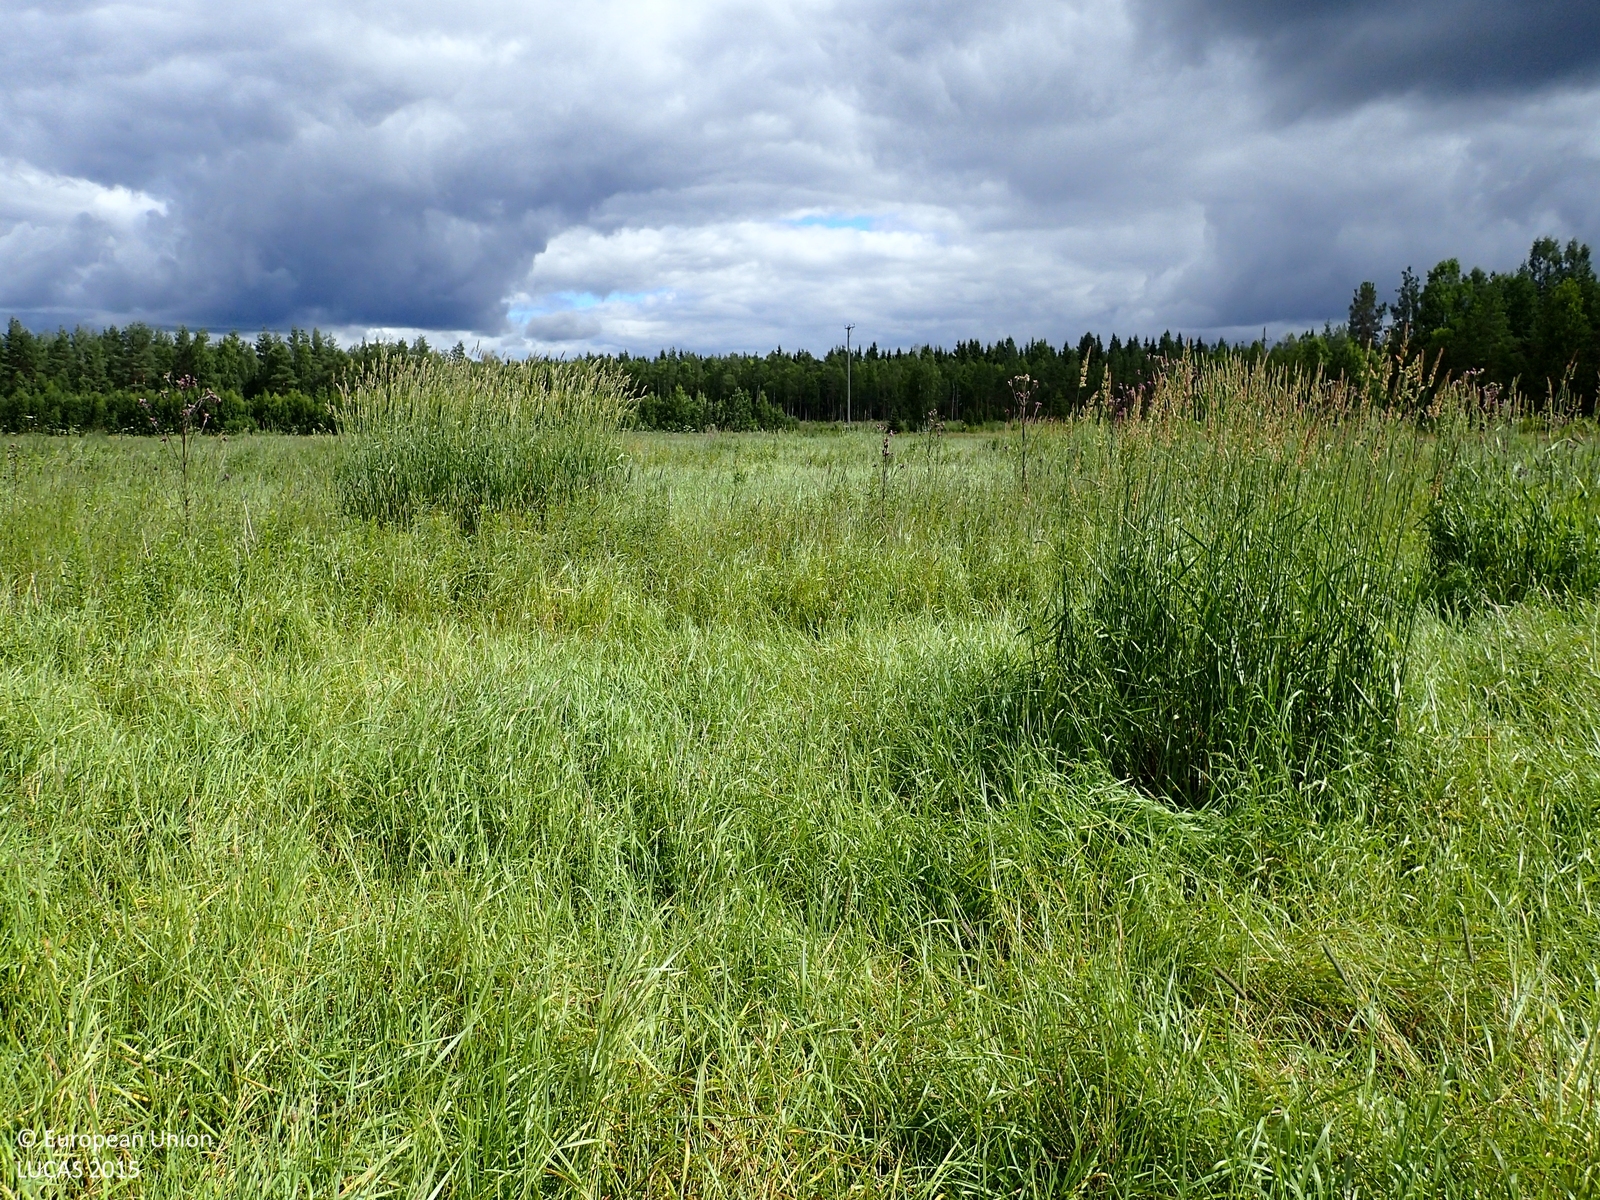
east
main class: Grassland
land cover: Spontaneously vegetated surfaces
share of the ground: > 75 %
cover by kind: herbaceous plants 100 %
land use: Fallow land
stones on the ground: < 10 %
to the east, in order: Spontaneously vegetated surfaces; Electric lines; Shruby margins; Ditches and canals; Shruby margins; Tracks; Shruby margins; Ditches and canals; Temporary grasslands; Ditches and canals; Temporary grasslands; Ditches and canals; Spontaneously vegetated surfaces; Ditches and canals; Abandoned hedges; Temporary grasslands; Abandoned hedges; Ditches and canals; Broadleaved woodland
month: August
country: FI
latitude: 62.6484
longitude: 21.6915
